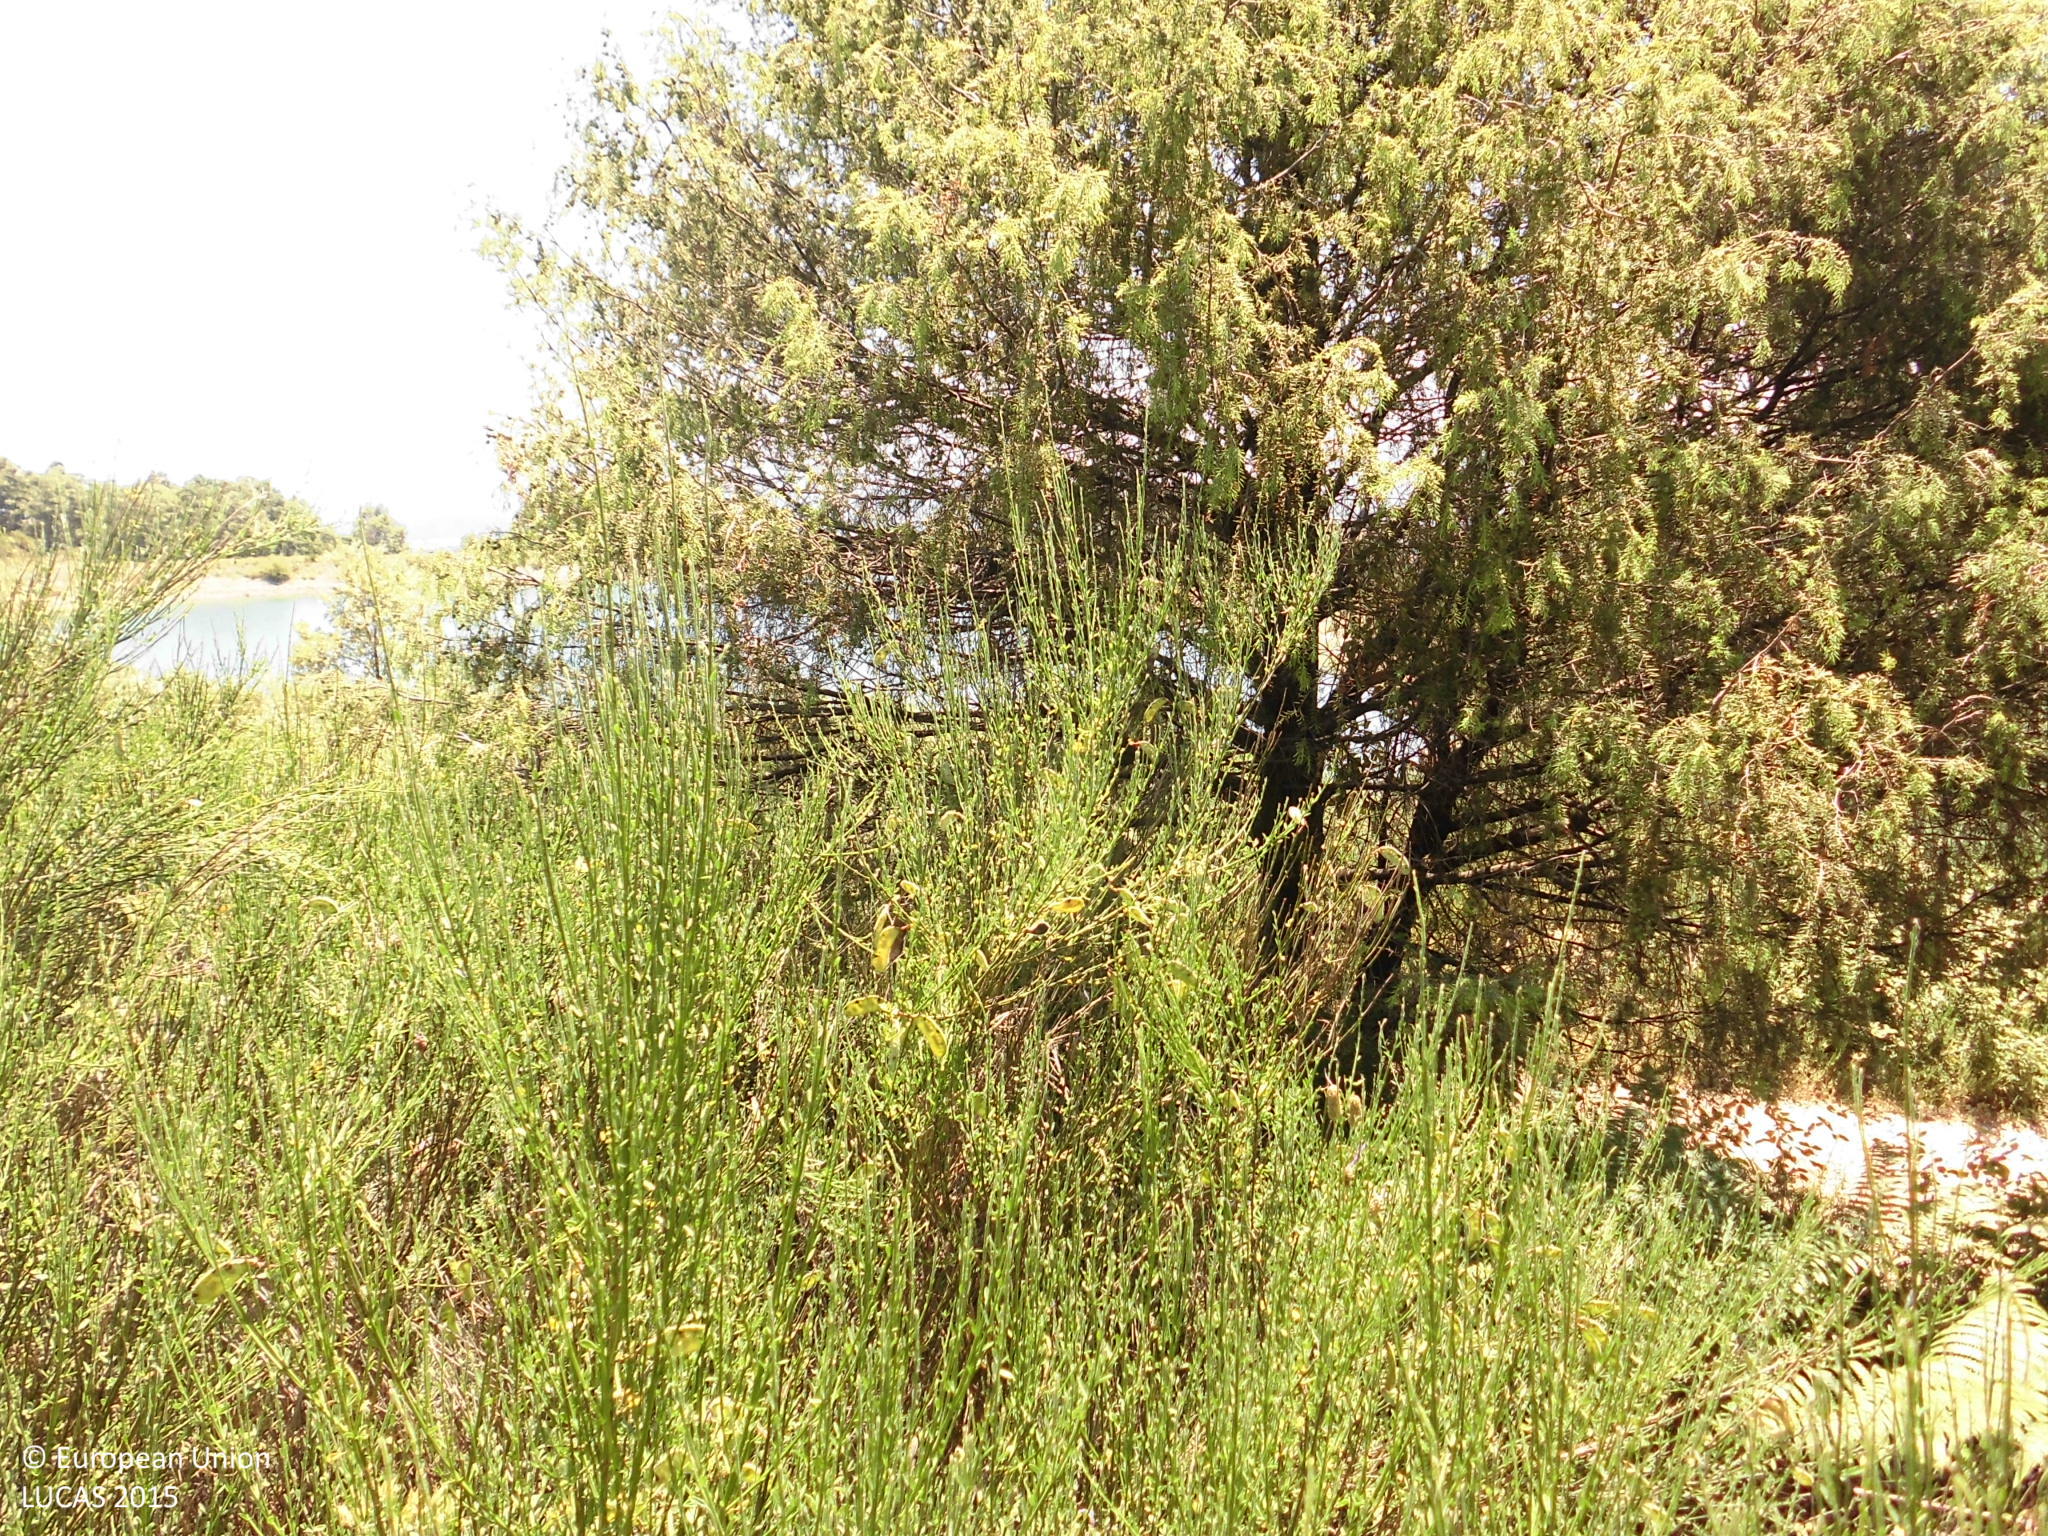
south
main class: Woodland
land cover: Broadleaved woodland
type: thermophilous deciduous forest
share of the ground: 10 - 25 %
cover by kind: shrubs 90 %, broadleaved forest trees 10 %
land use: Forestry
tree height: > 5 m
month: June
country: ES
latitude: 40.1309
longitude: -5.4942
